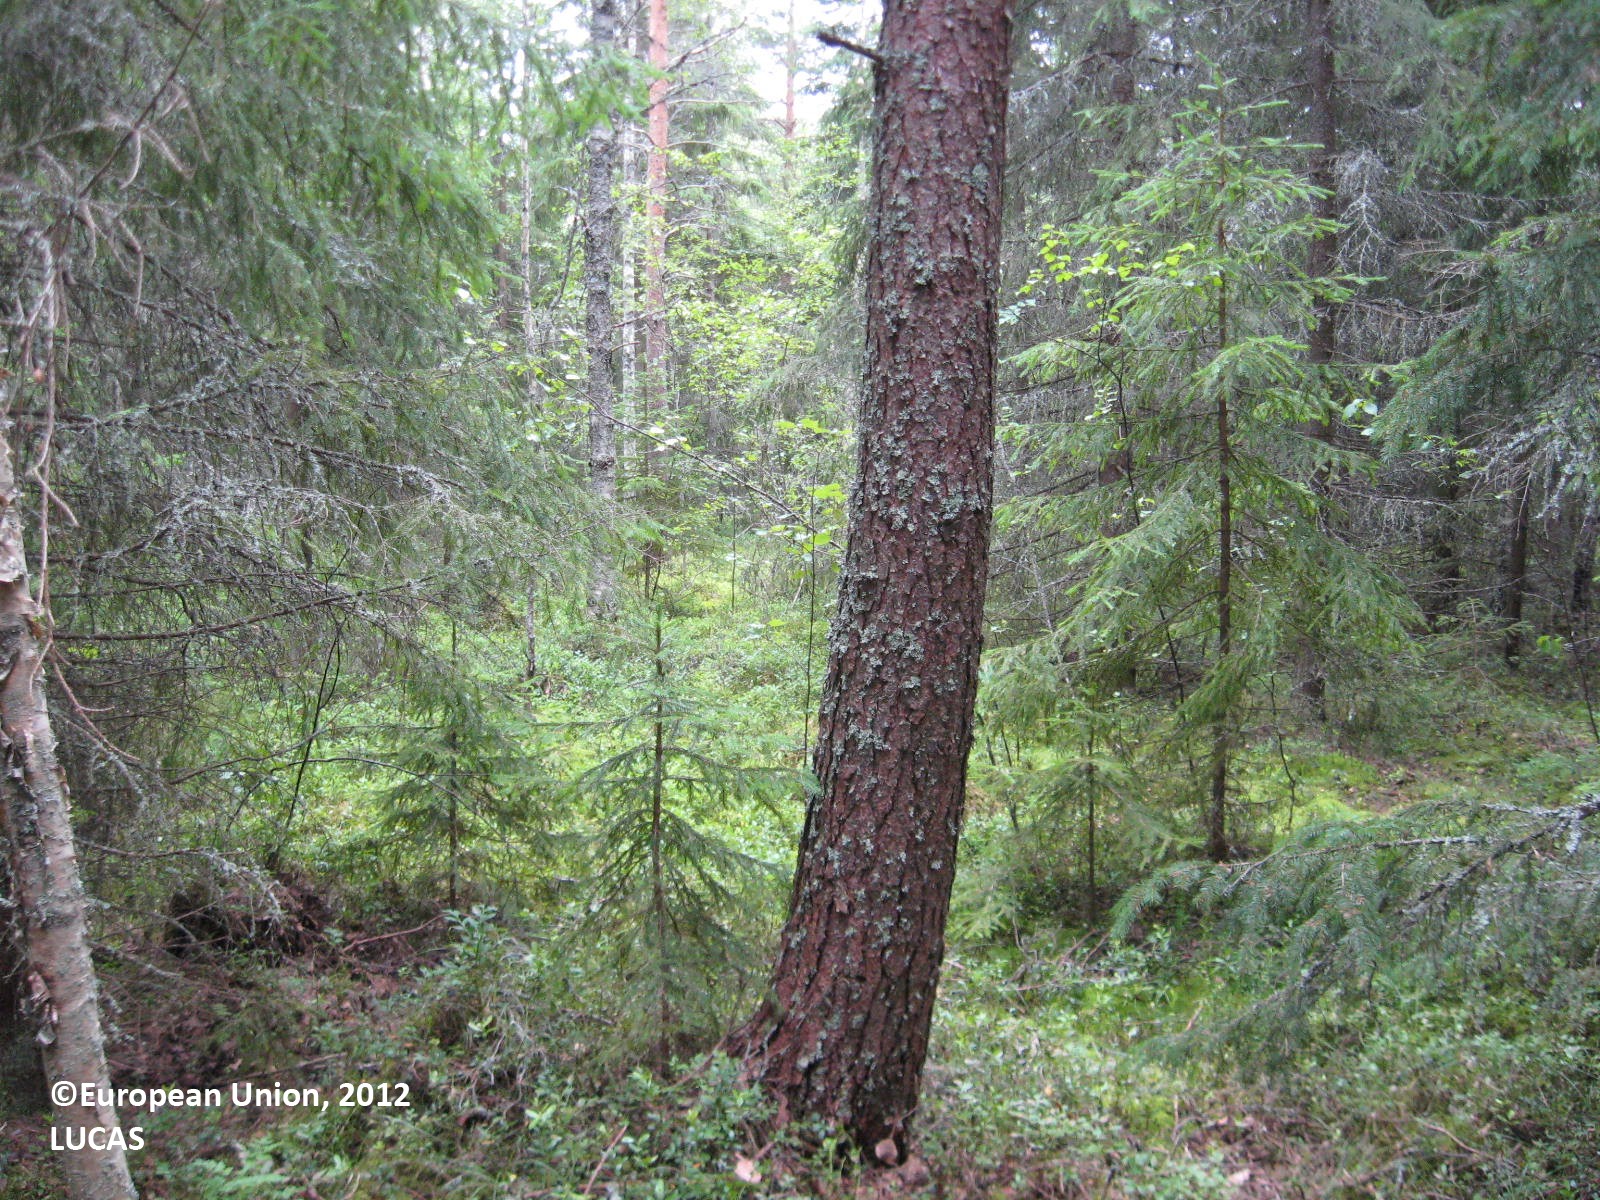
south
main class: Woodland
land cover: Spruce dominated coniferous woodland
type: boreal forest
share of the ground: > 75 %
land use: Forestry
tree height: > 5 m
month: July
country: FI
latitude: 62.5387
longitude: 21.2168
